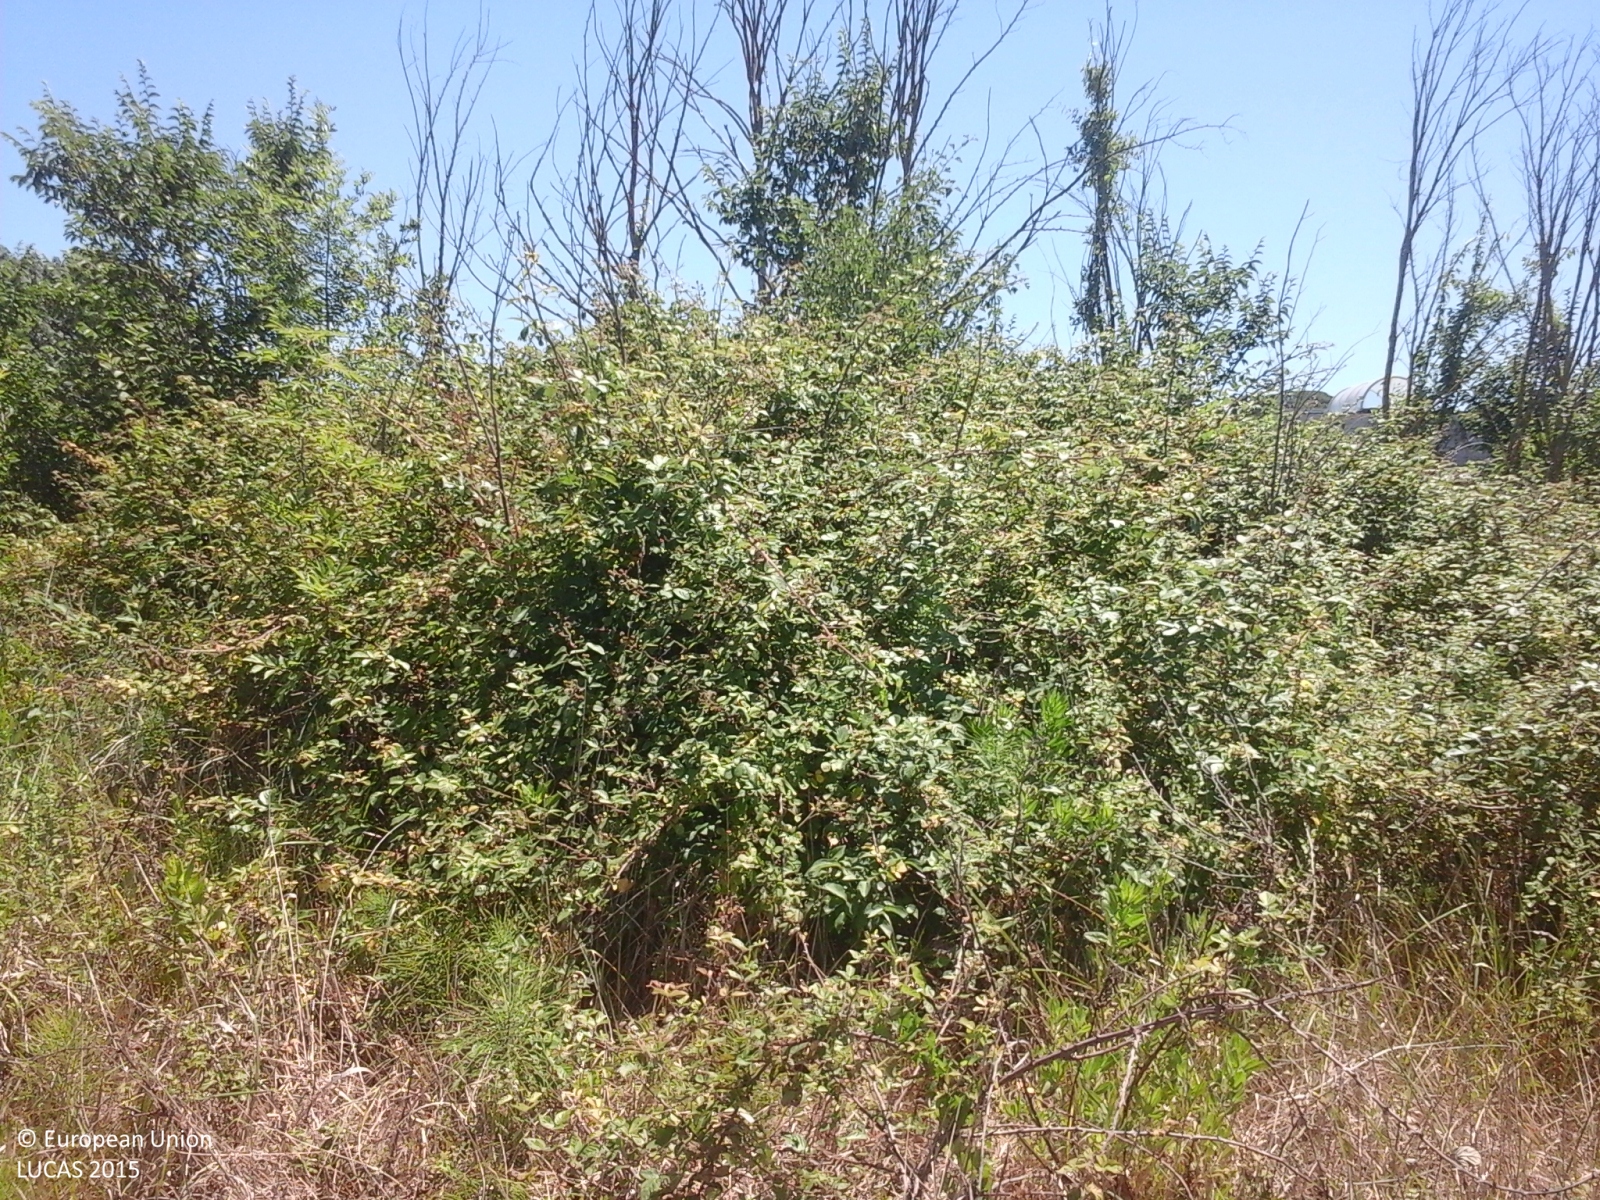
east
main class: Grassland
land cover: Grassland with sparse tree/shrub cover
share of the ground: 50 - 75 %
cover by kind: herbaceous plants 85 %, shrubs 10 %, broadleaved forest trees 5 %
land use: Semi-natural and natural areas not in use
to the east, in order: Grassland with sparse tree/shrub cover; Artificial constructions in urban areas; Grassland with sparse tree/shrub cover; Artificial constructions in urban areas
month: June
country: IT
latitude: 43.6091
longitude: 10.6054
